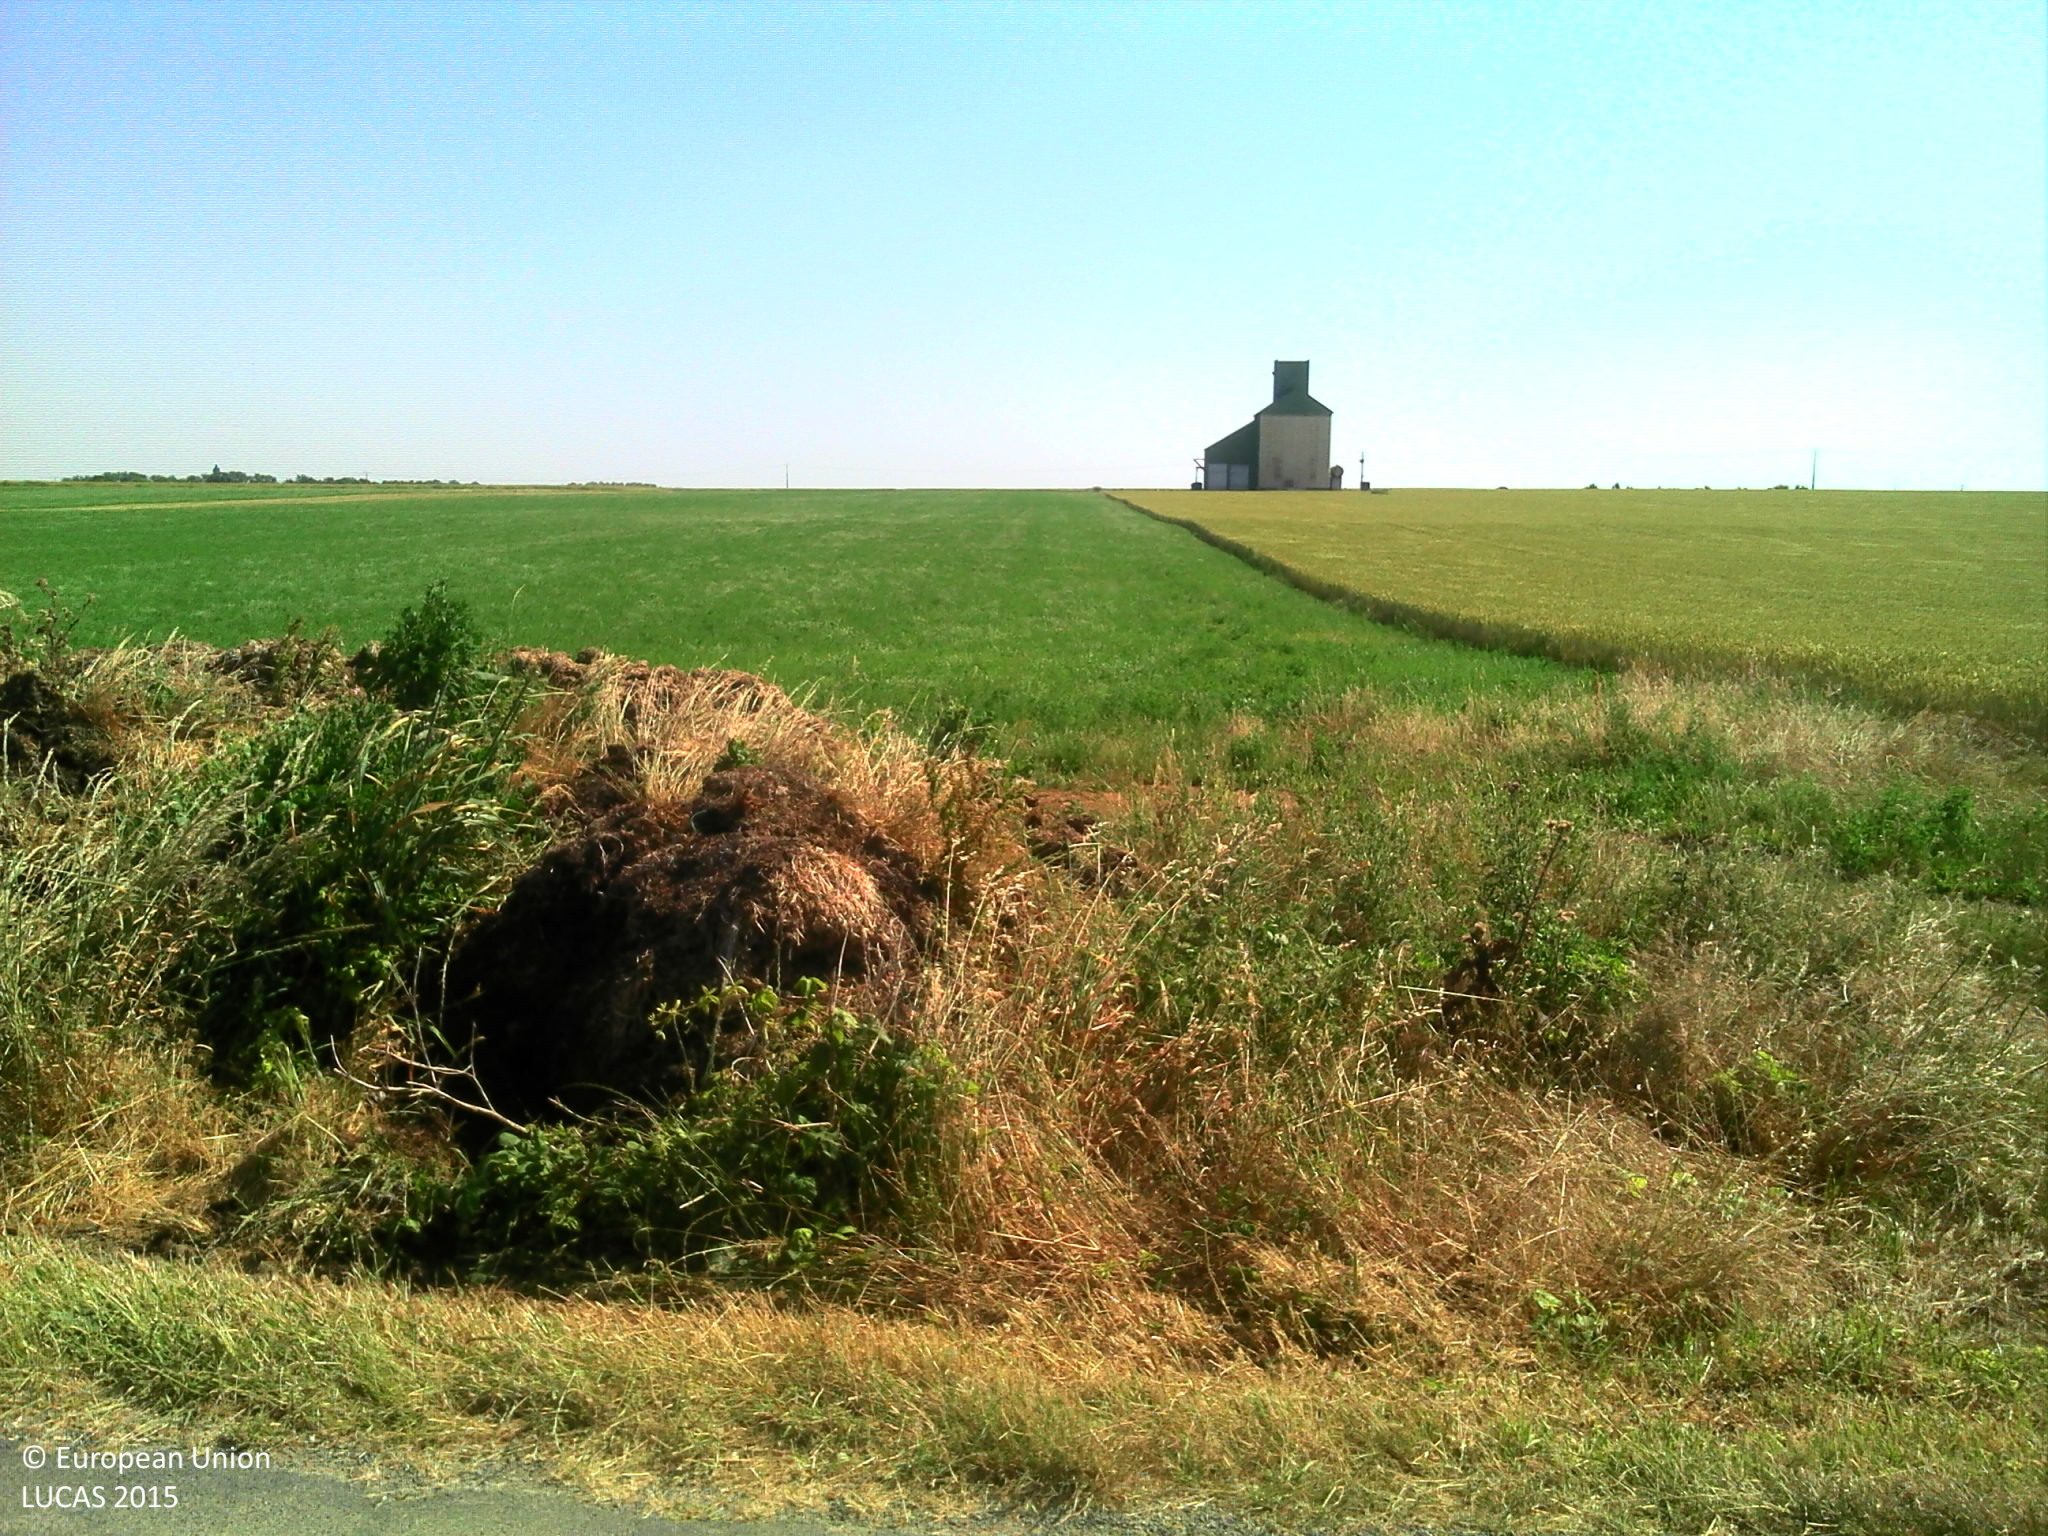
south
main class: Cropland
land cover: Mixed cereals for fodder
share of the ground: > 75 %
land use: Agriculture (excluding fallow land and kitchen gardens)
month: June
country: FR
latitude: 46.0872
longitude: -1.0360
